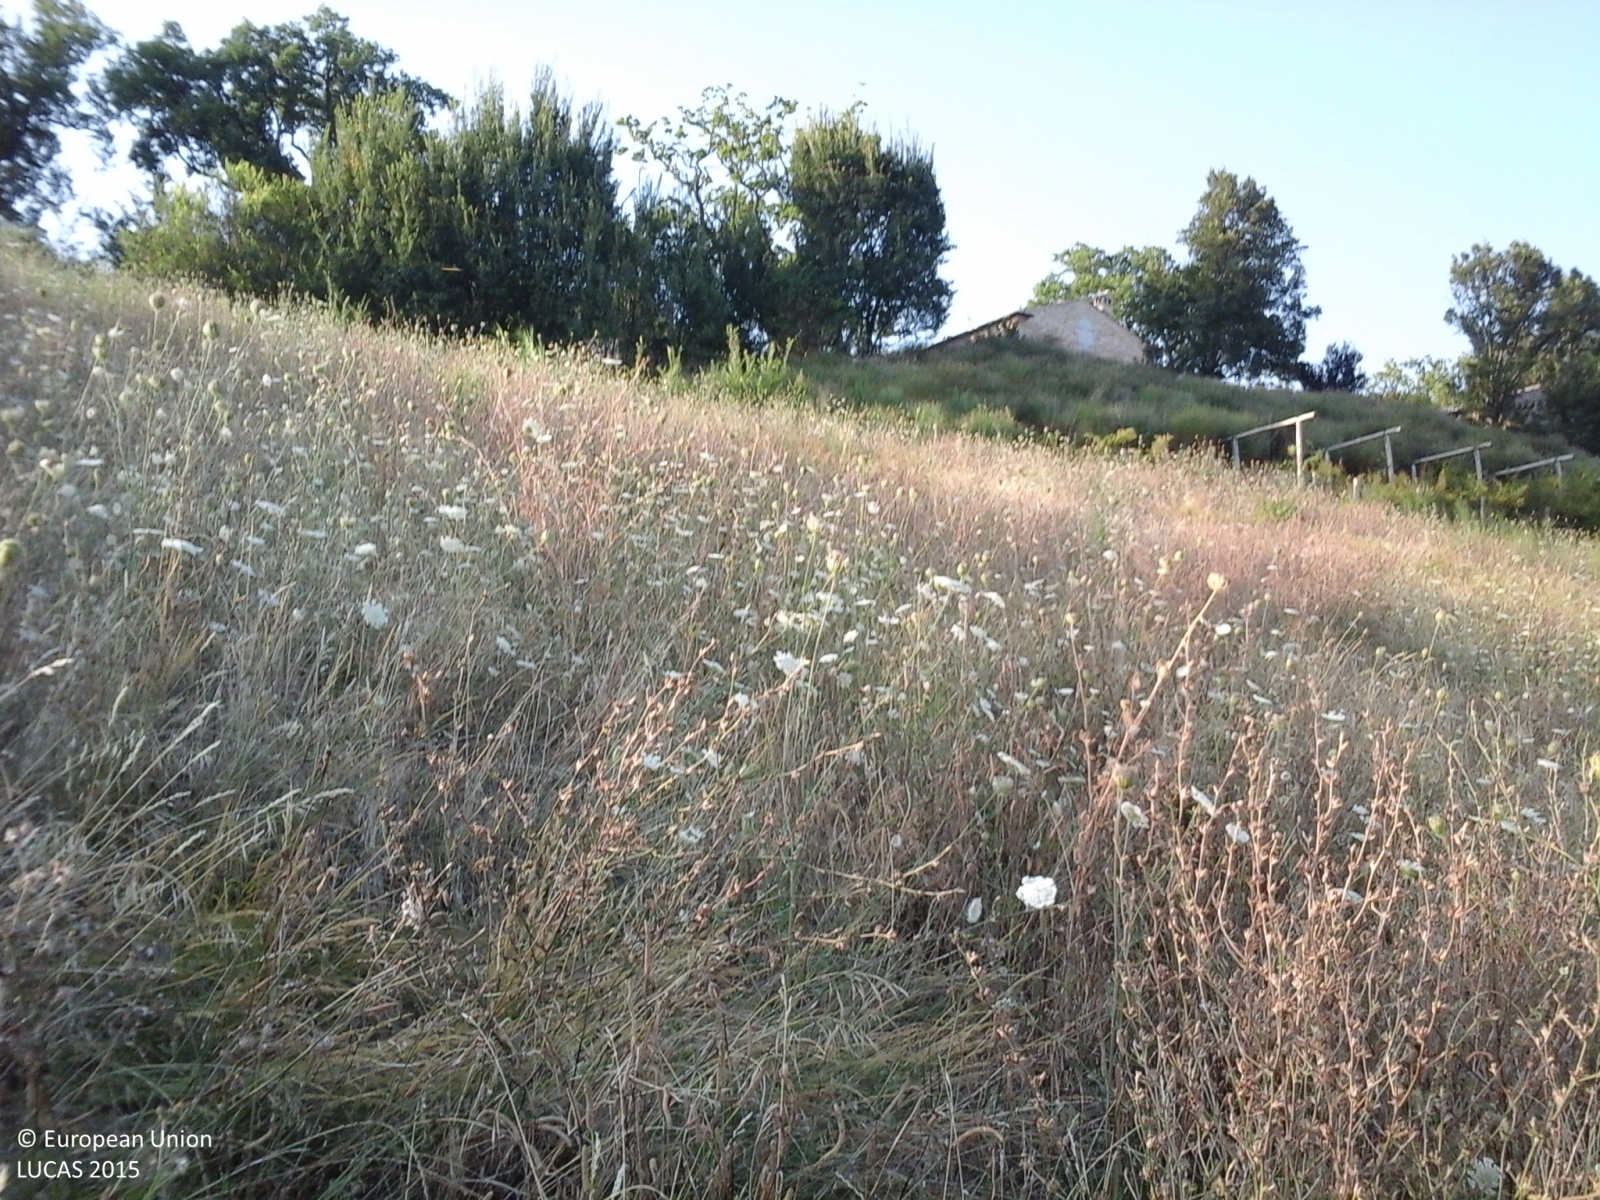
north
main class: Grassland
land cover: Spontaneously vegetated surfaces
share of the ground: > 75 %
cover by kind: herbaceous plants 100 %
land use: Fallow land
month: August
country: IT
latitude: 43.1548
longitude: 13.4710
